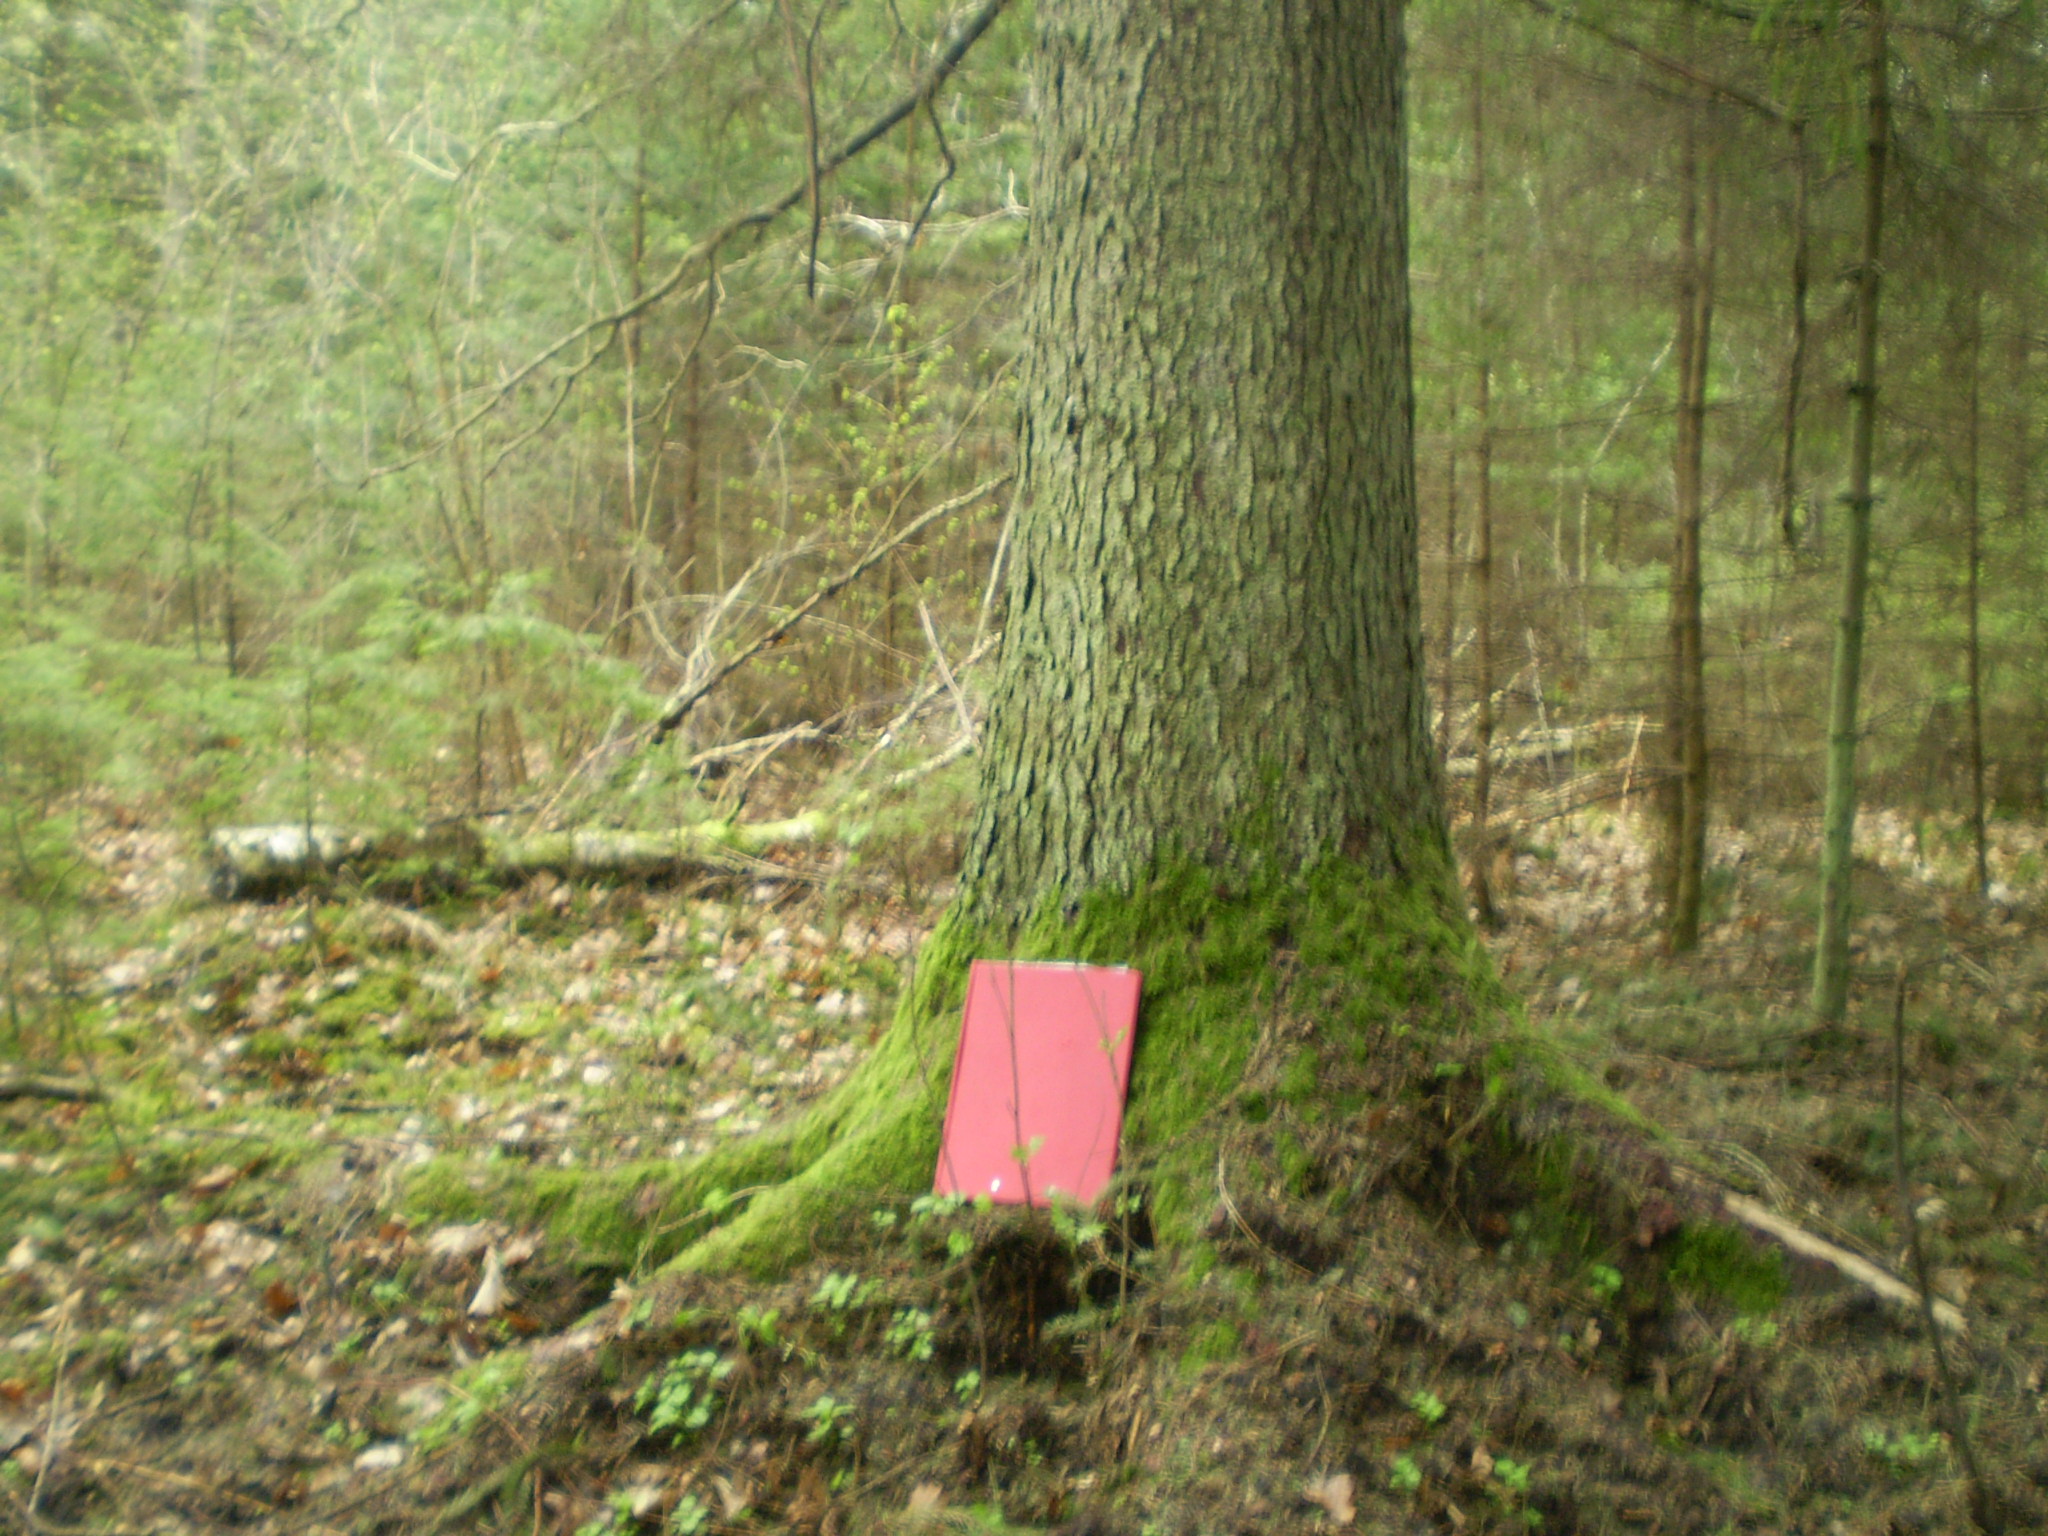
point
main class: Woodland
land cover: Spruce dominated coniferous woodland
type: hemiboreal forest and nemoral coniferous forest and mixed broadleaved-coniferous forest
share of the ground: > 75 %
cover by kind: coniferous forest trees 85 %, broadleaved forest trees 15 %
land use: Forestry
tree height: > 5 m
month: May
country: LT
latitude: 56.2874
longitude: 22.0870
